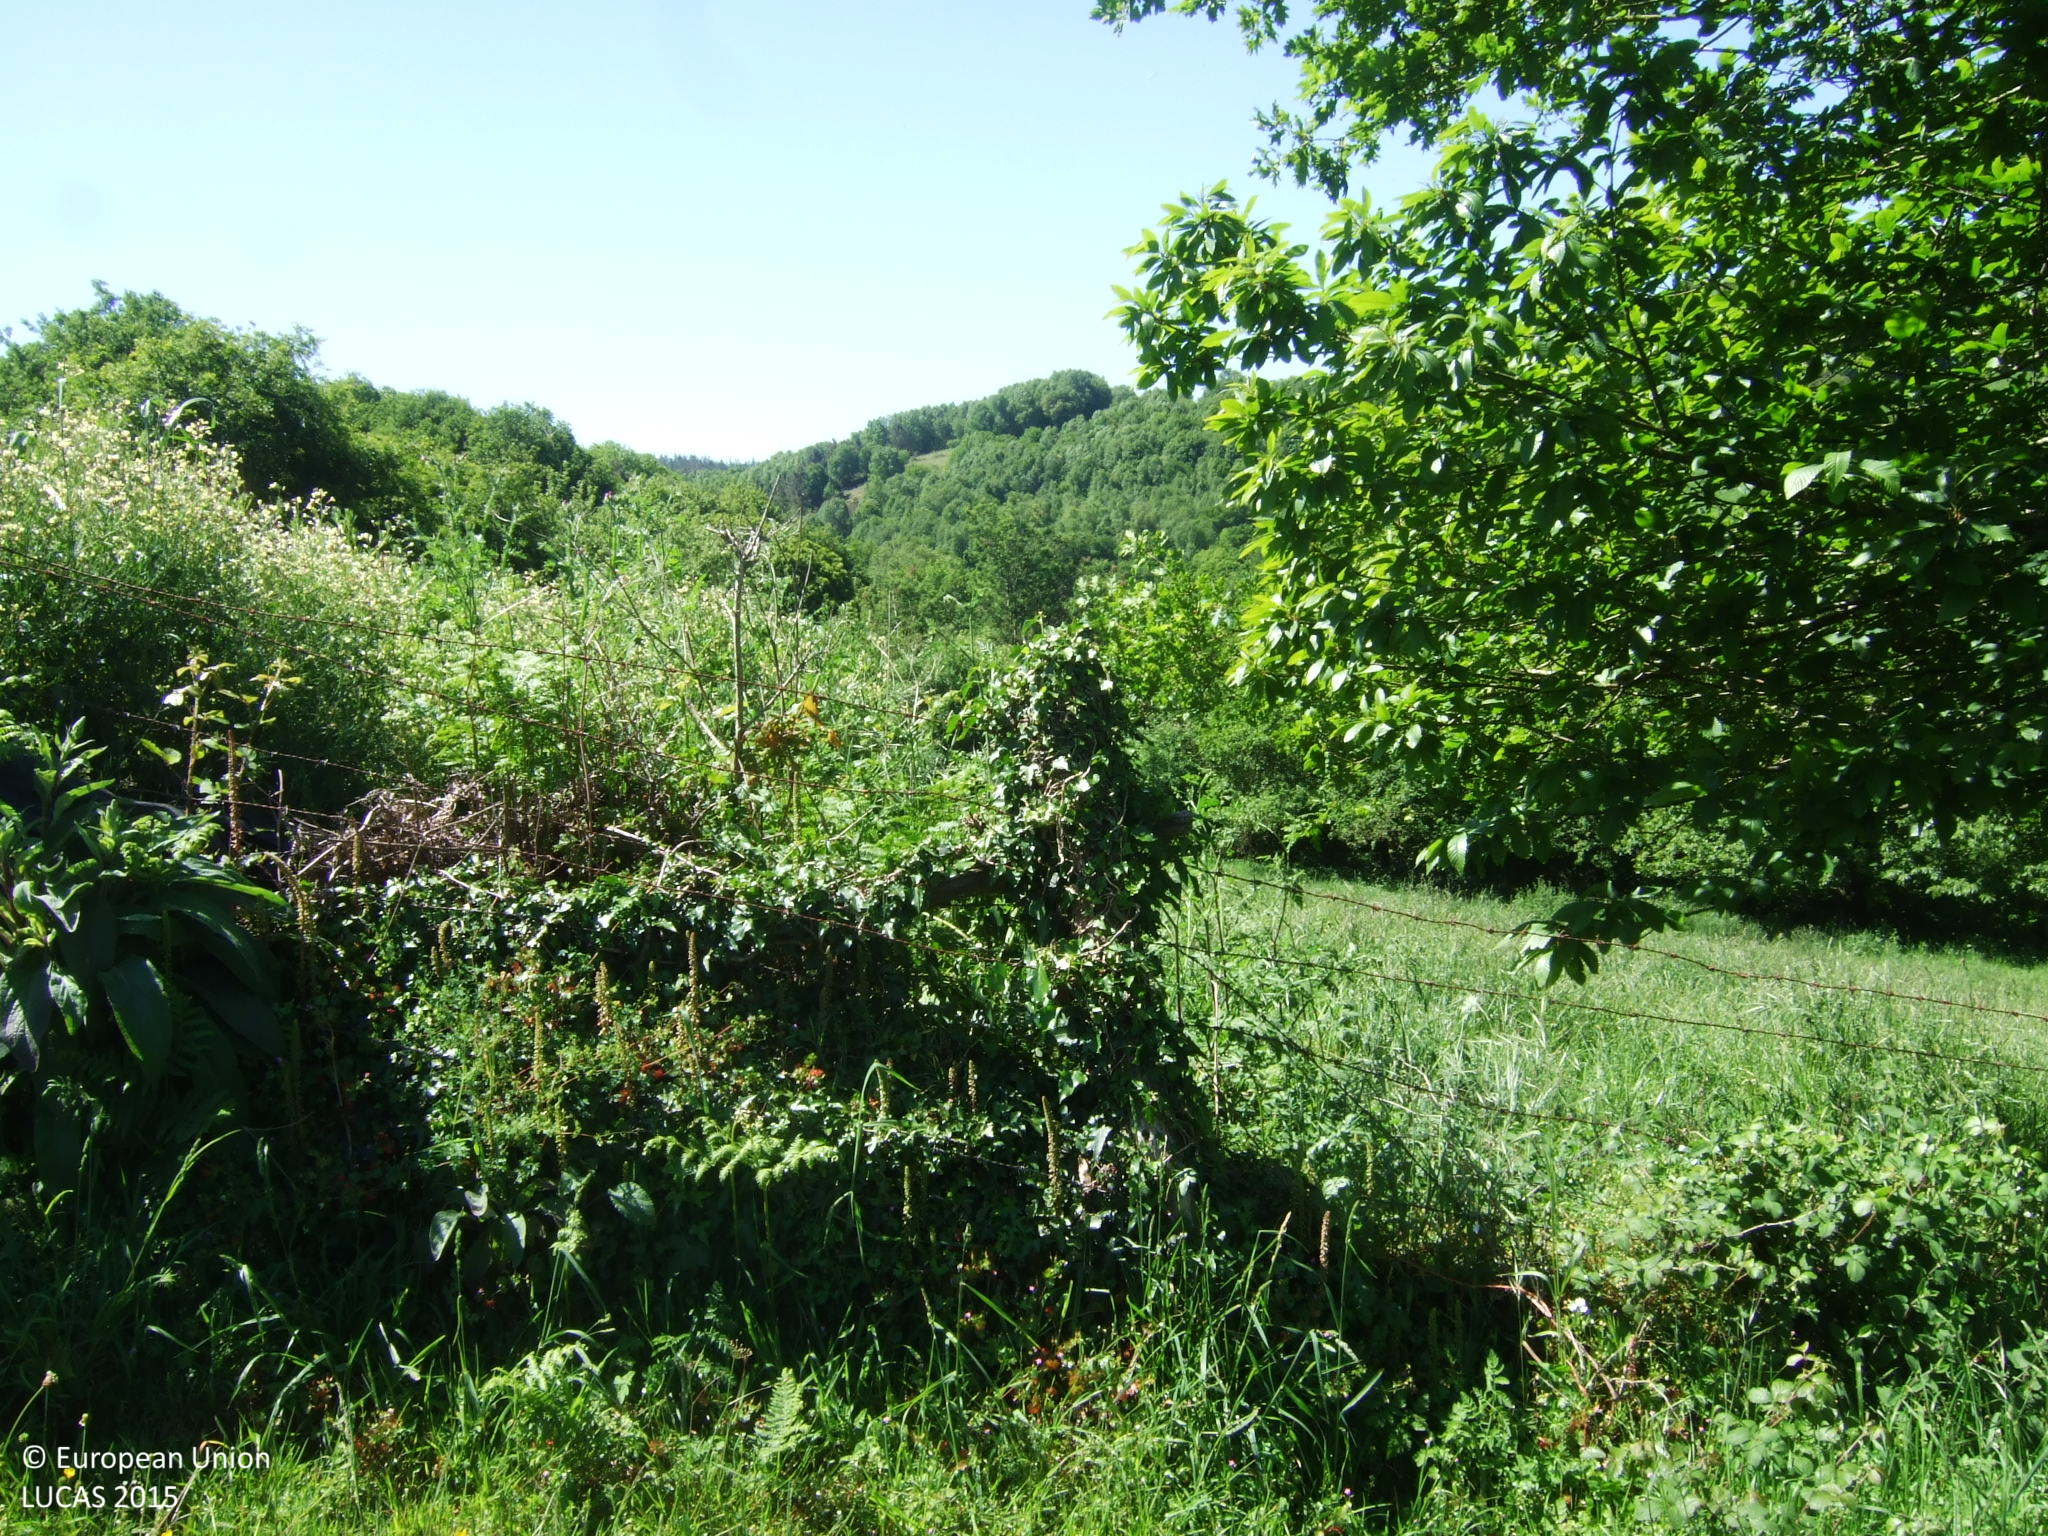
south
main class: Grassland
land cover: Grassland without tree/shrub cover
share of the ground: > 75 %
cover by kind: herbaceous plants 100 %
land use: Agriculture (excluding fallow land and kitchen gardens)
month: May
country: ES
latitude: 42.7430
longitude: -7.5799
